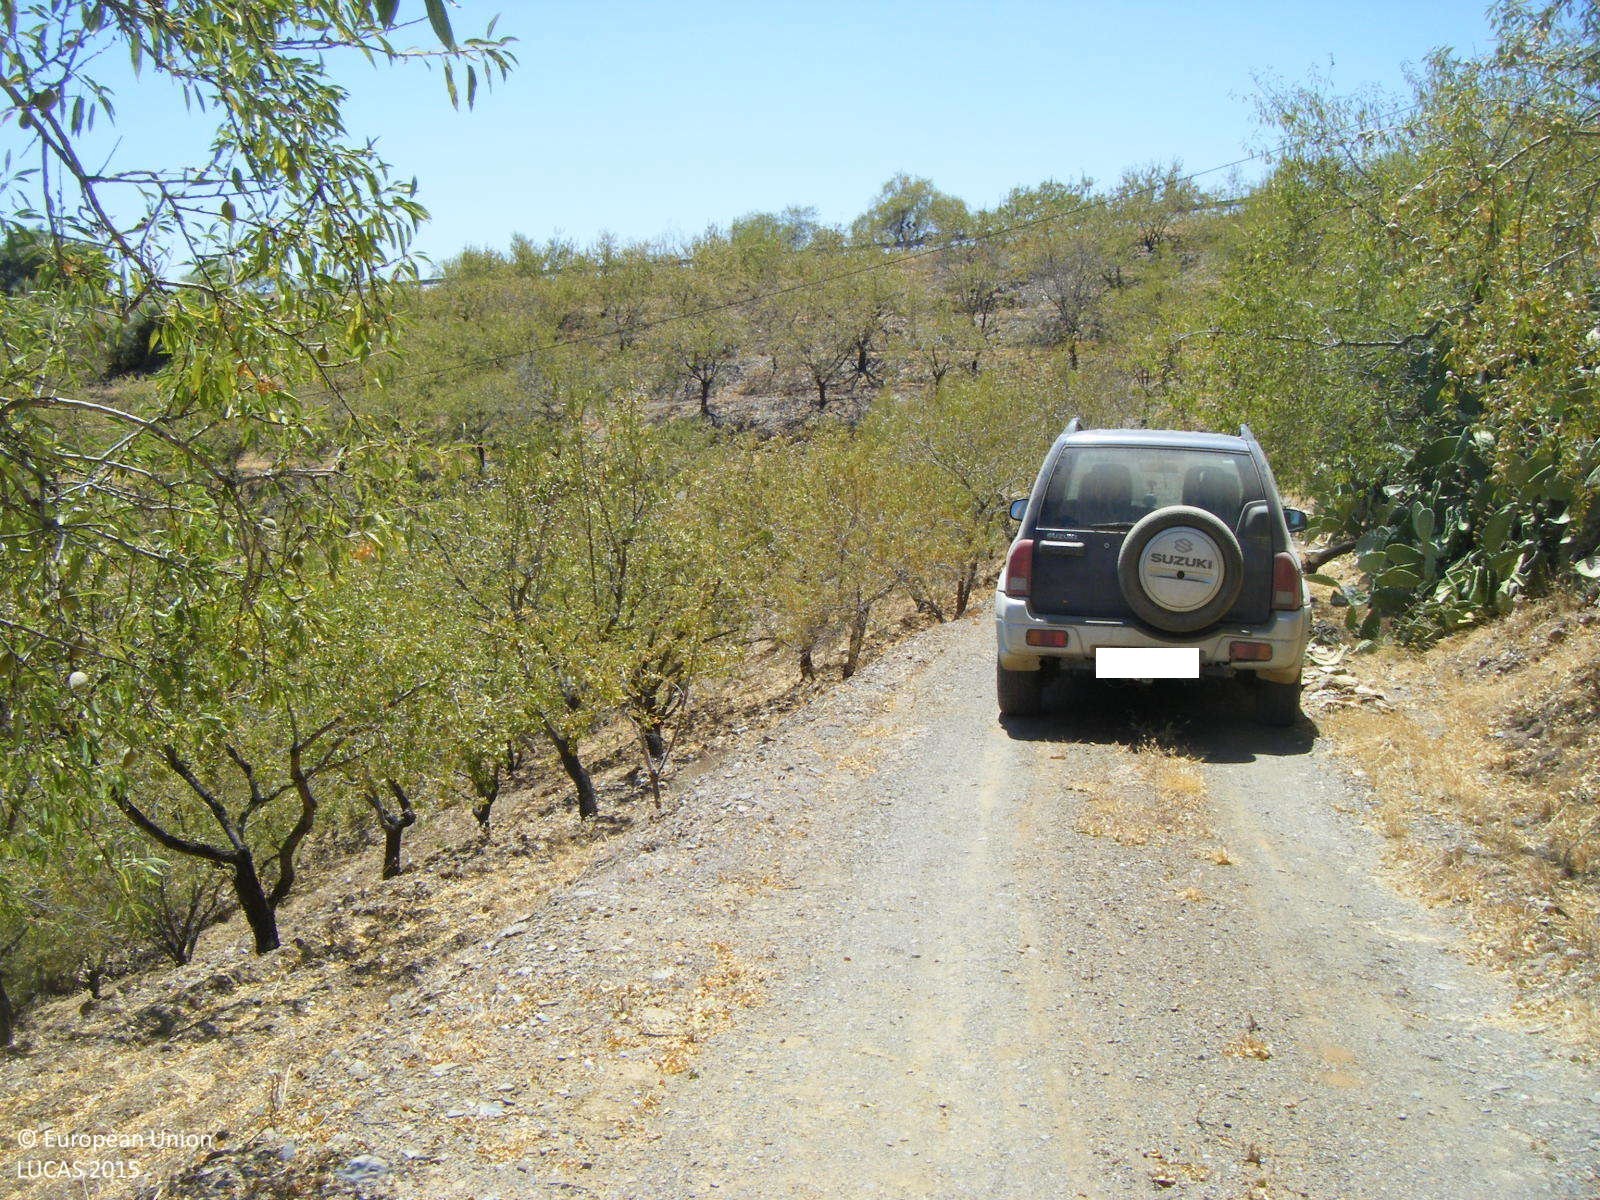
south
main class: Cropland
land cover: Nuts trees
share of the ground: 10 - 25 %
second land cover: Spontaneously vegetated surfaces
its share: > 75 %
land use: Agriculture (excluding fallow land and kitchen gardens)
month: July
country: ES
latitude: 36.8039
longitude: -4.3257
